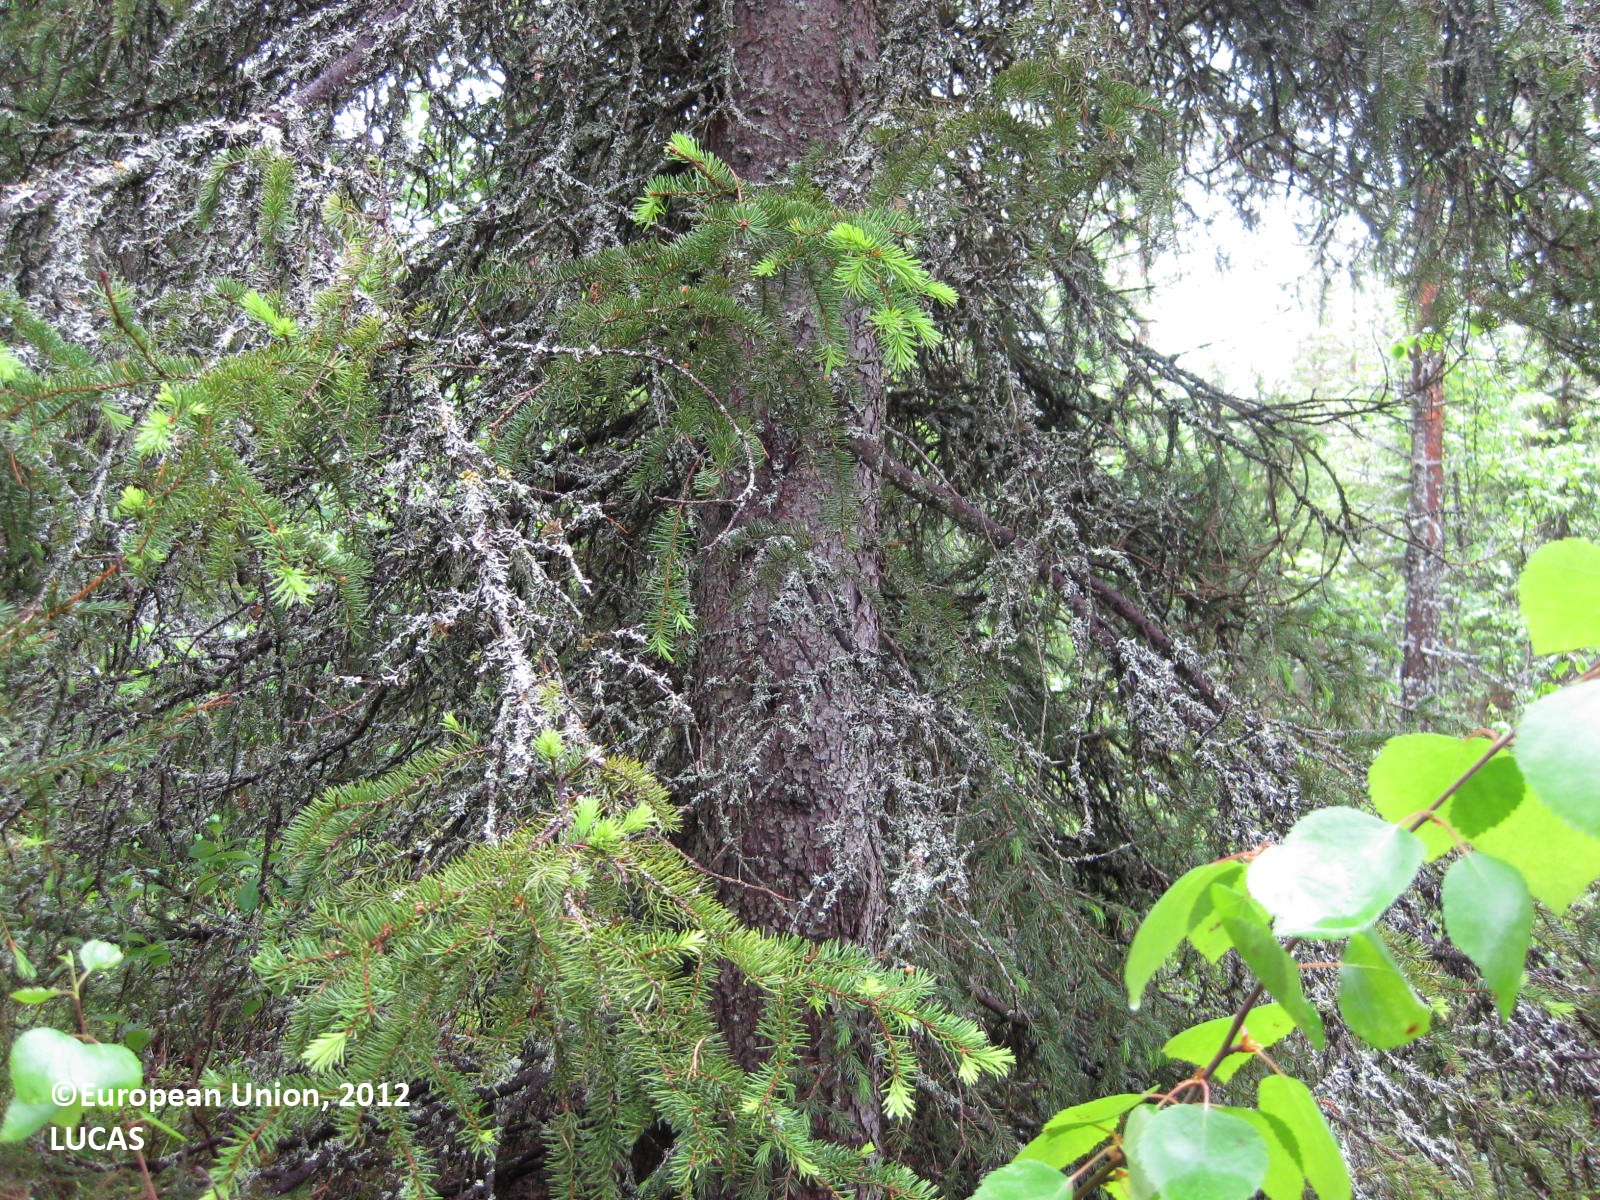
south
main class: Woodland
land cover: Other mixed woodland
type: boreal forest
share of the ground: > 75 %
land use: Forestry
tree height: > 5 m
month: June
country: FI
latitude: 65.0837
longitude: 29.0129
